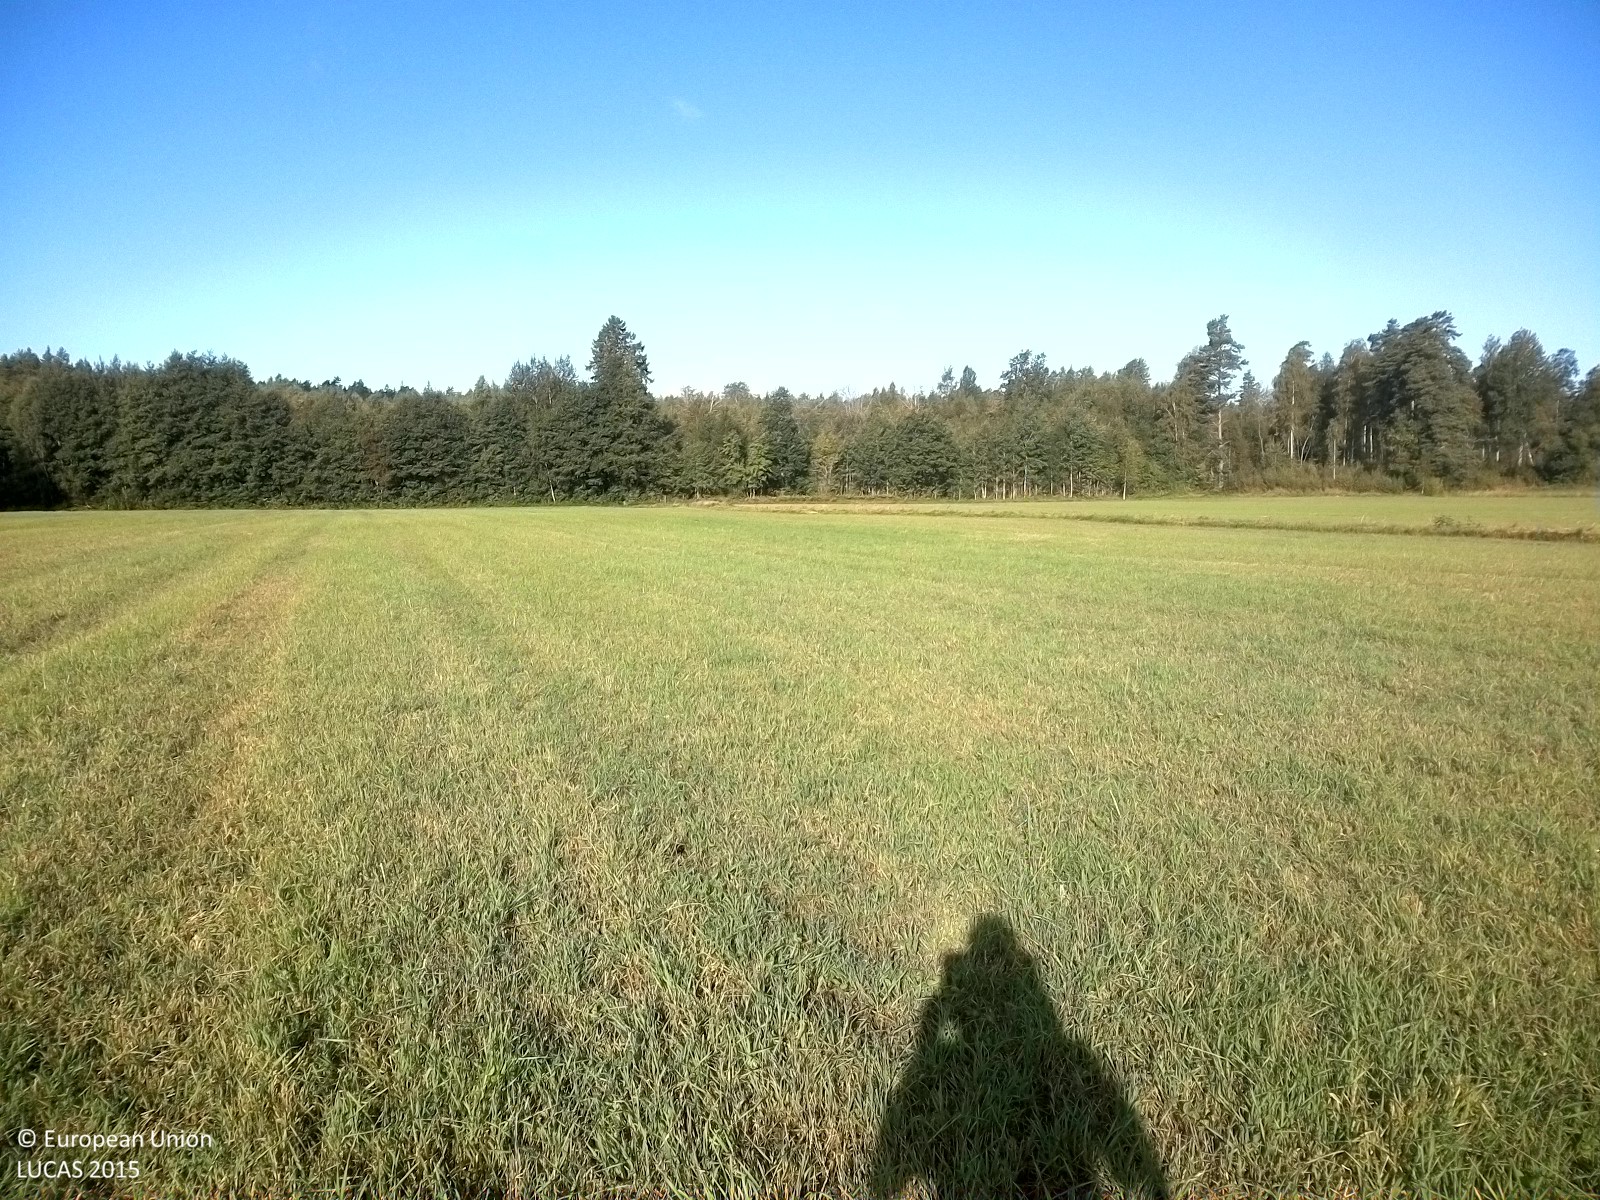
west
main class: Grassland
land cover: Grassland without tree/shrub cover
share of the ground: > 75 %
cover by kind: herbaceous plants 100 %
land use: Agriculture (excluding fallow land and kitchen gardens)
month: August
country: SE
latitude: 59.1159
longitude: 15.5291
